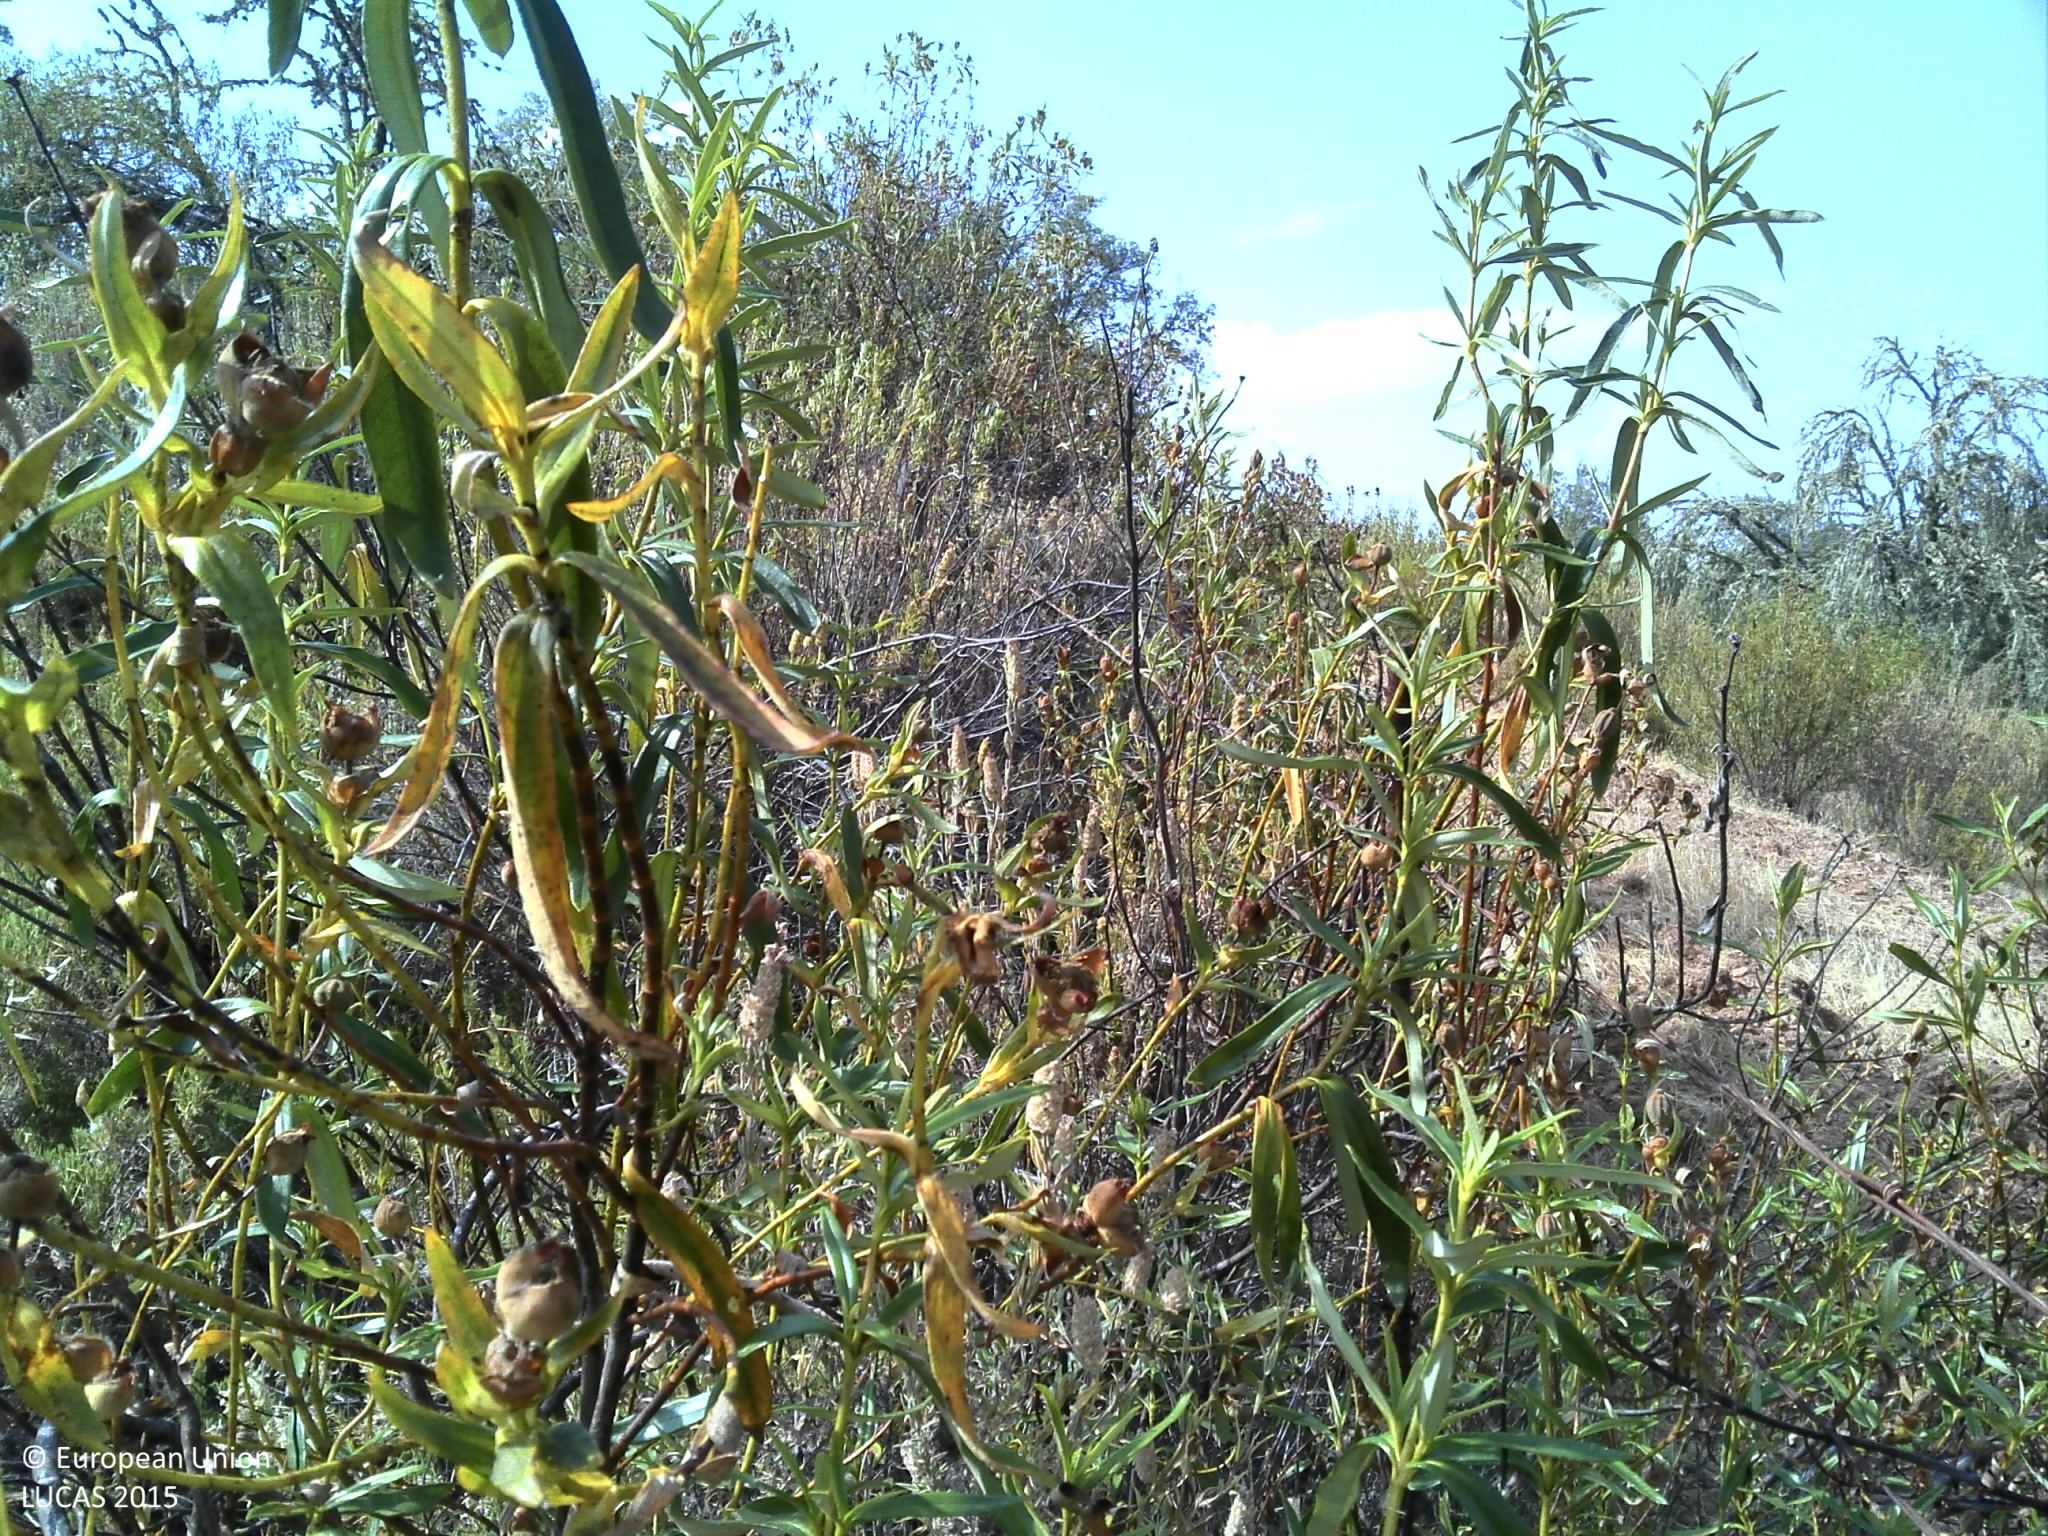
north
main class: Shrubland
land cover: Shrubland with sparse tree cover
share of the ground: > 75 %
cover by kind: shrubs 75 %, unconsolidated bare surface 15 %, broadleaved forest trees 5 %, herbaceous plants 5 %
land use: Forestry
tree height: > 5 m
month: June
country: PT
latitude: 37.8181
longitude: -7.5682
